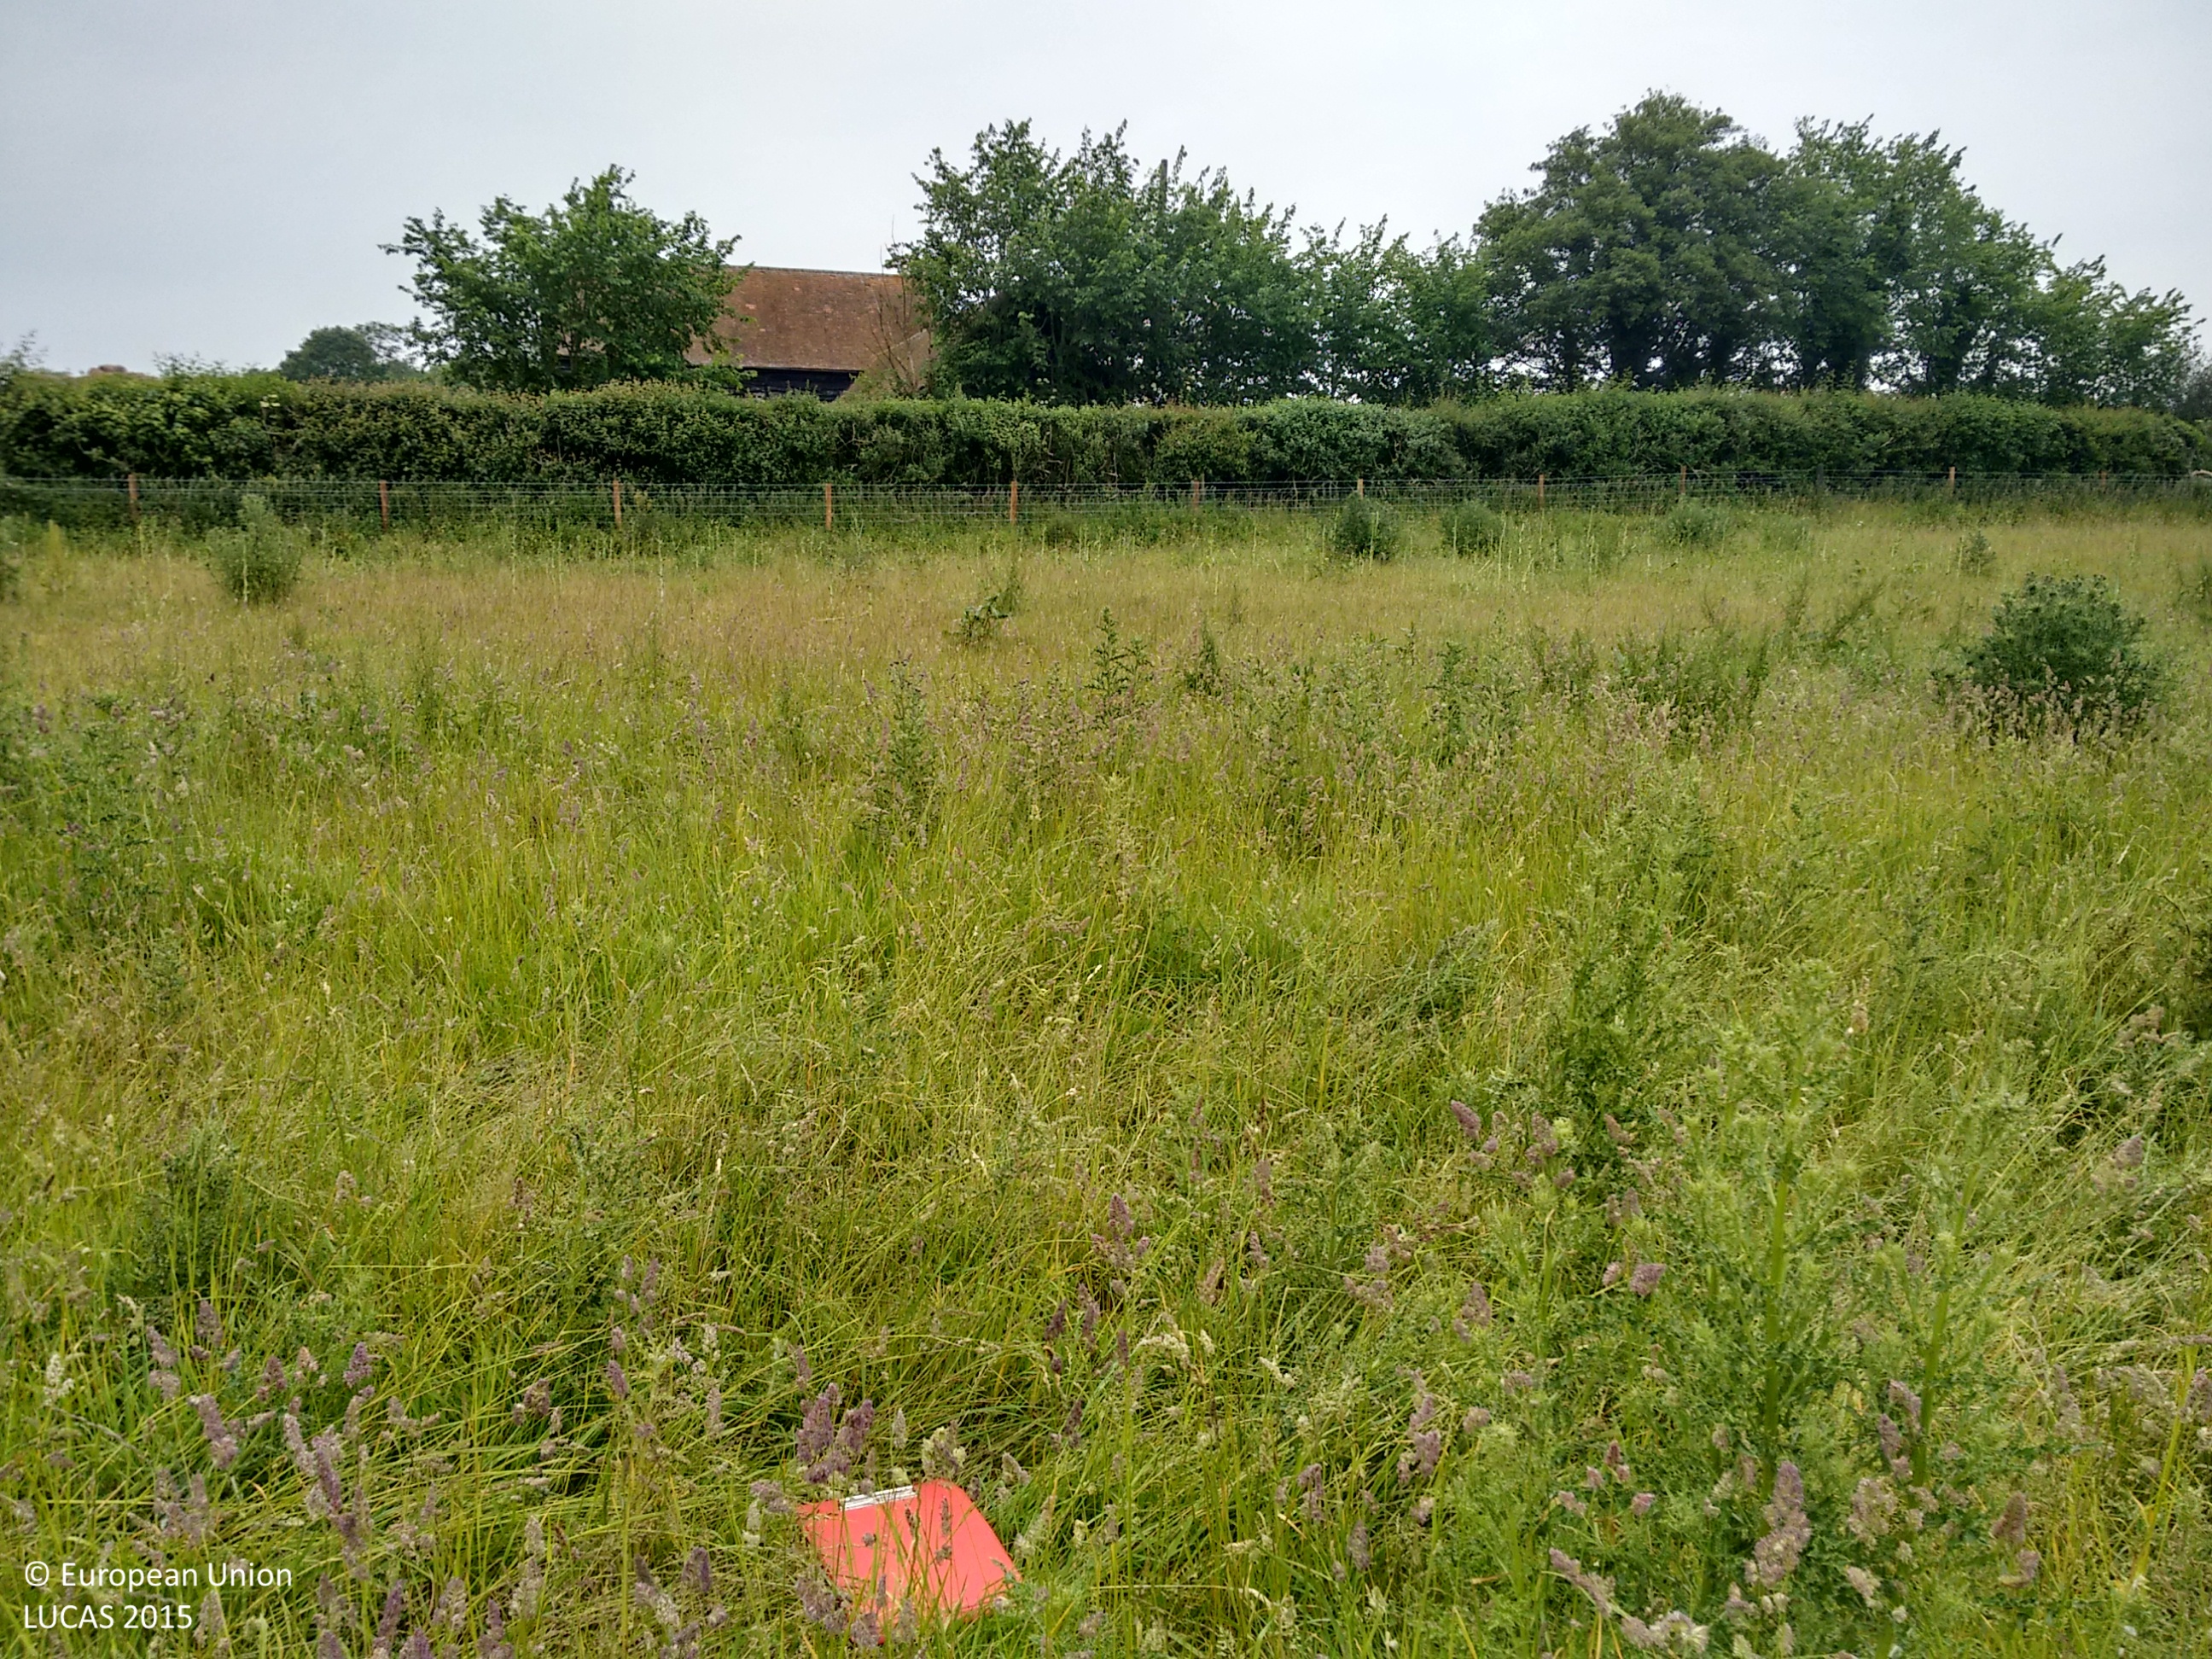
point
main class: Grassland
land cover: Grassland without tree/shrub cover
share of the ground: > 75 %
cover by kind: herbaceous plants 100 %
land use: Agriculture (excluding fallow land and kitchen gardens)
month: June
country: GB
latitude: 51.4518
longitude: -1.1412
